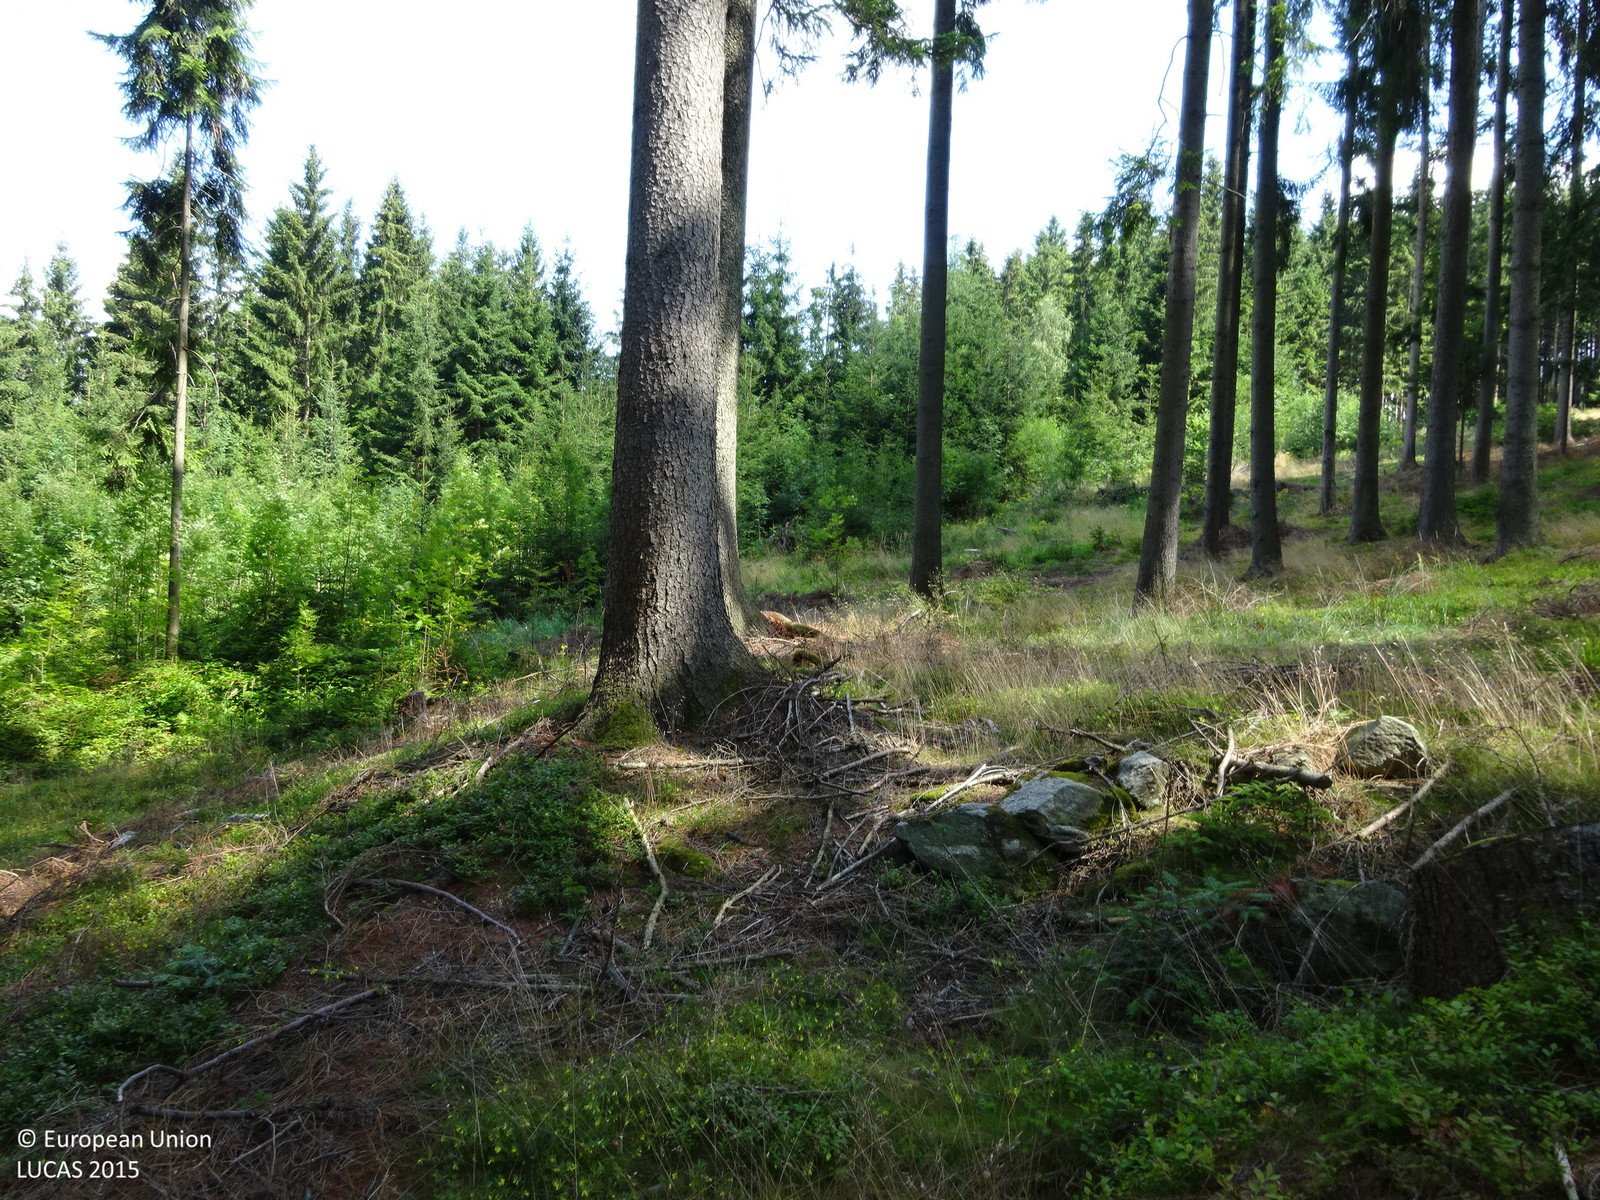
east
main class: Woodland
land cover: Spruce dominated coniferous woodland
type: alpine coniferous forest
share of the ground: > 75 %
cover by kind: coniferous forest trees 95 %, herbaceous plants 5 %
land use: Forestry
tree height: > 5 m
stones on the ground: < 10 %
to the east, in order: Spruce dominated coniferous woodland; Spruce dominated mixed woodland; Spruce dominated coniferous woodland; Tracks; Spruce dominated coniferous woodland; Tracks; Broadleaved woodland; Fences; Broadleaved woodland; Grassland without tree/shrub cover; Pear fruit; Grassland without tree/shrub cover; Lines of trees; Tracks; Grassland without tree/shrub cover; Electric lines; Grassland without tree/shrub cover
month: August
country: AT
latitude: 47.3154
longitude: 15.7558
